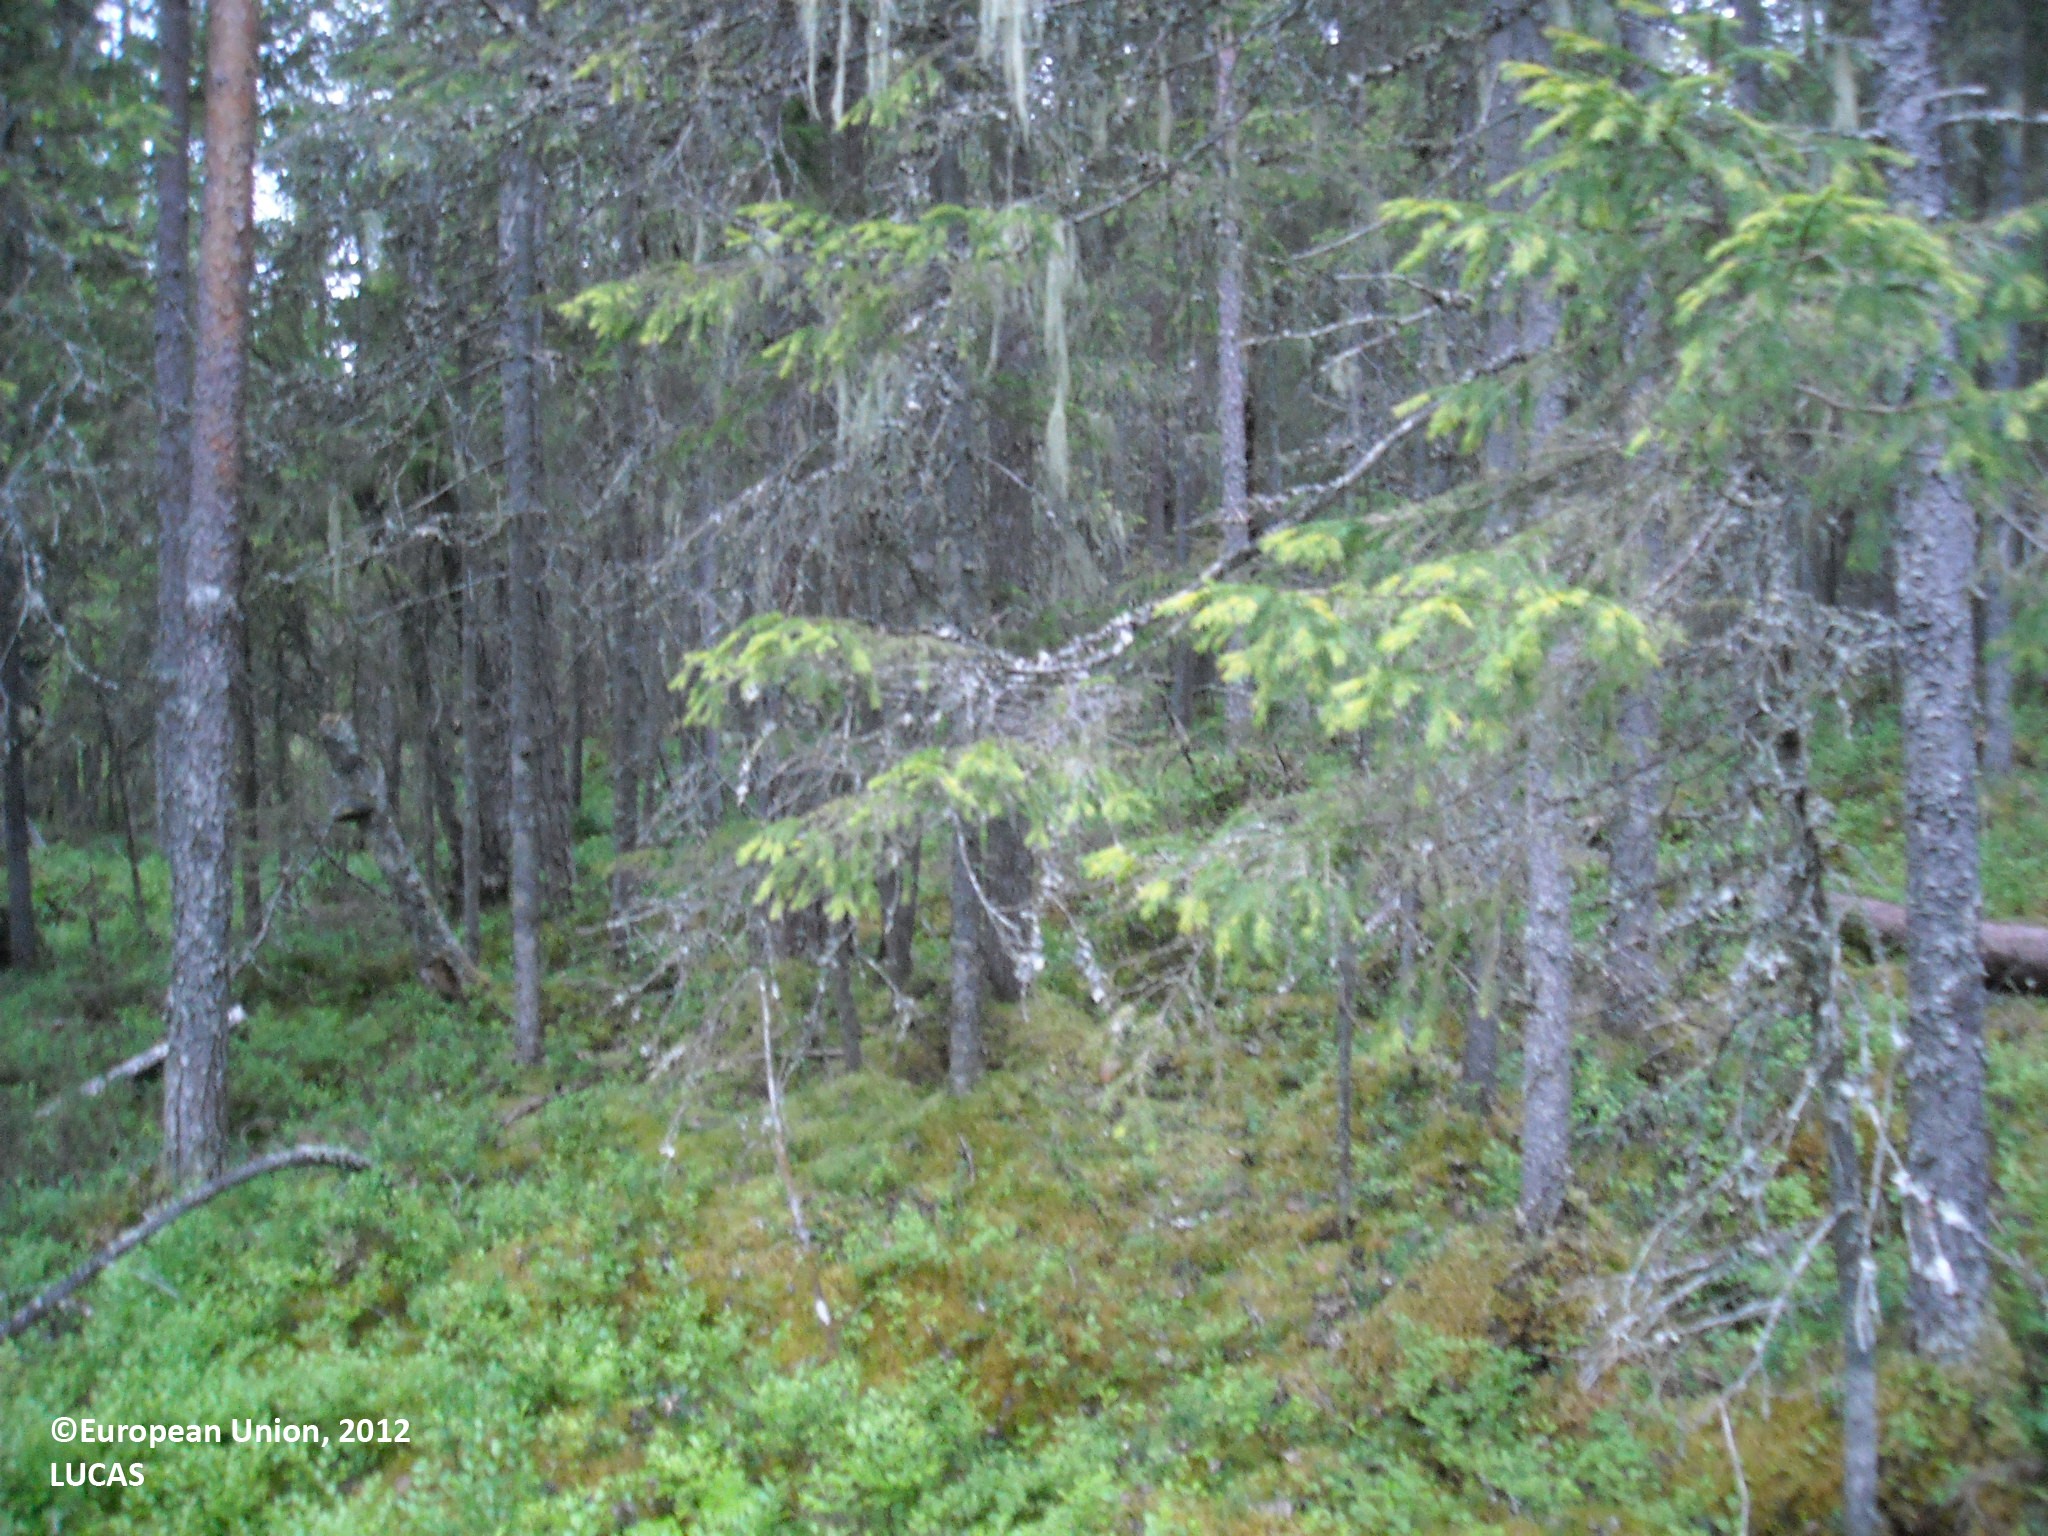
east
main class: Woodland
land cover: Other coniferous woodland
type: boreal forest
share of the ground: > 75 %
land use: Semi-natural and natural areas not in use
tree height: > 5 m
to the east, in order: Other coniferous woodland; Pine dominated coniferous woodland; Ditches and canals; Pine dominated coniferous woodland; Ditches and canals; Pine dominated coniferous woodland
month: July
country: FI
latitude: 65.0223
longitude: 26.7326
